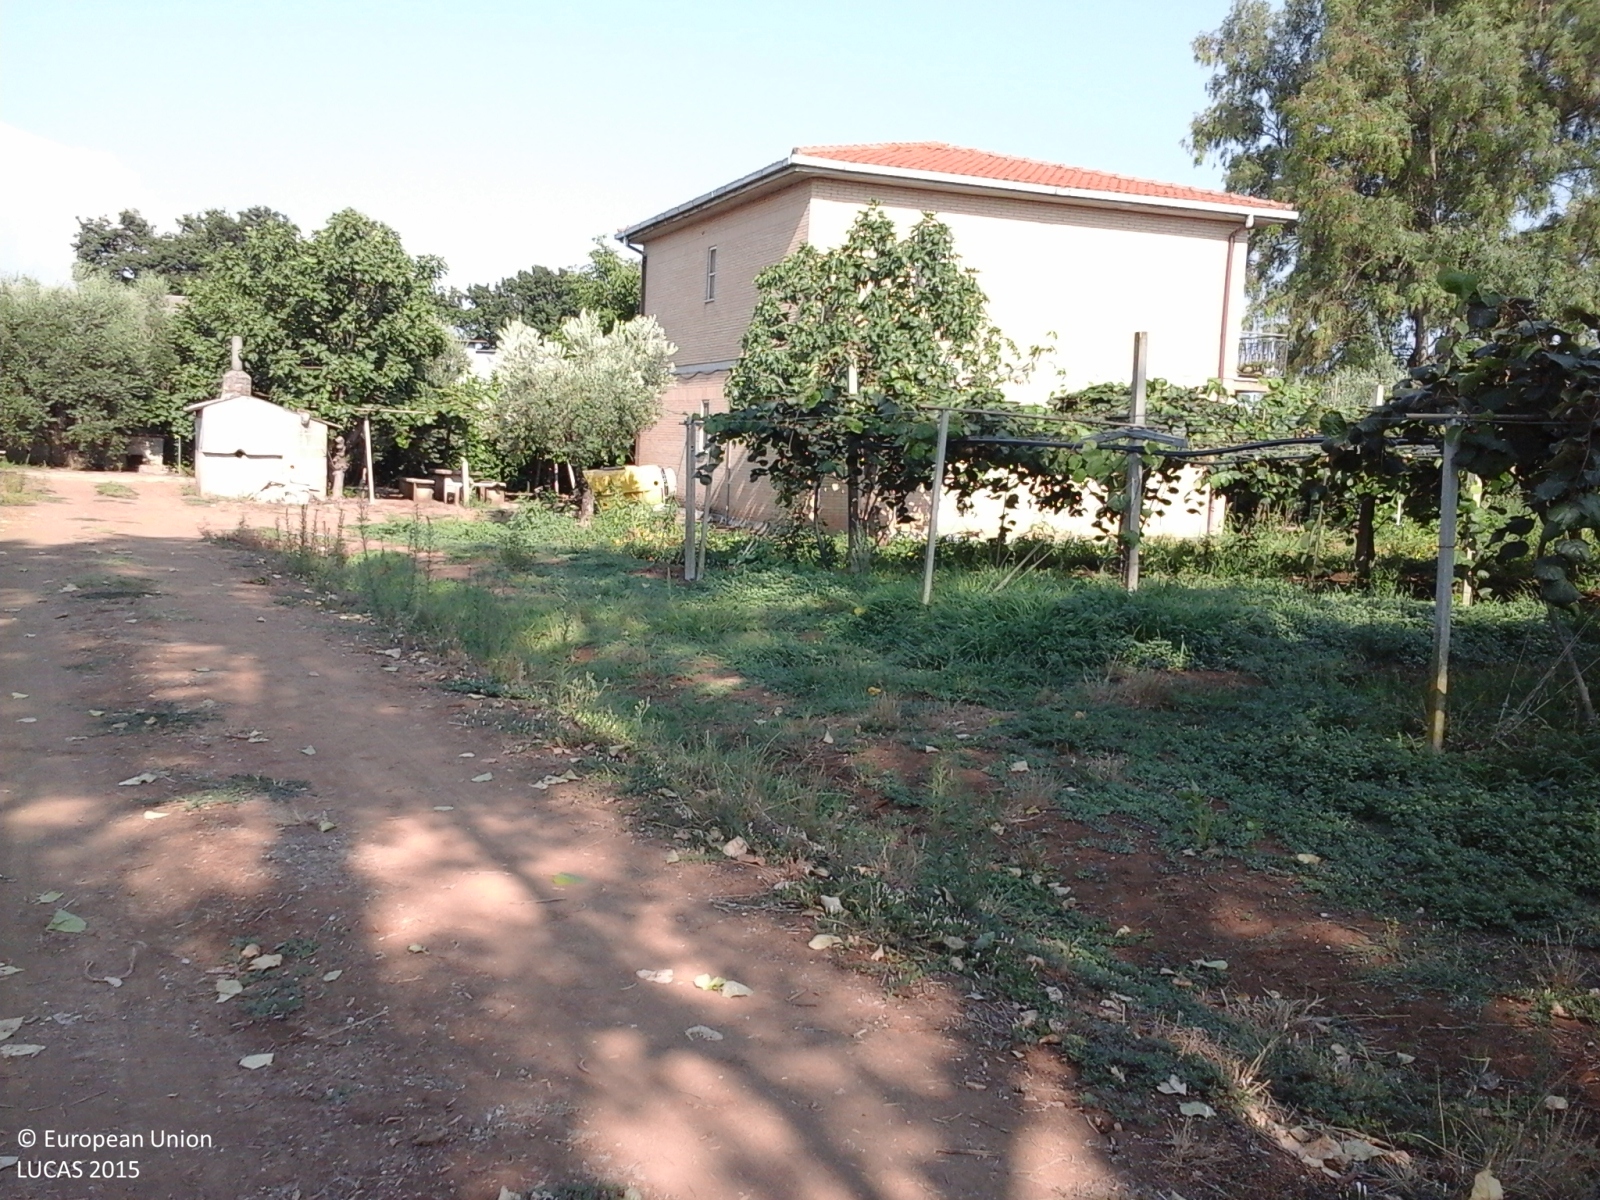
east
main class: Cropland
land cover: Other fruit trees and berries
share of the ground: > 75 %
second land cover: Grassland without tree/shrub cover
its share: > 75 %
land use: Agriculture (excluding fallow land and kitchen gardens)
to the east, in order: Other fruit trees and berries; Grassland without tree/shrub cover; Other citrus fruit; Olive groves; Other fruit trees and berries; Grassland without tree/shrub cover; Tracks; Ditches and canals; Grassland without tree/shrub cover; Arable land (only in case pi)
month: July
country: IT
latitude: 41.5659
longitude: 12.8309
